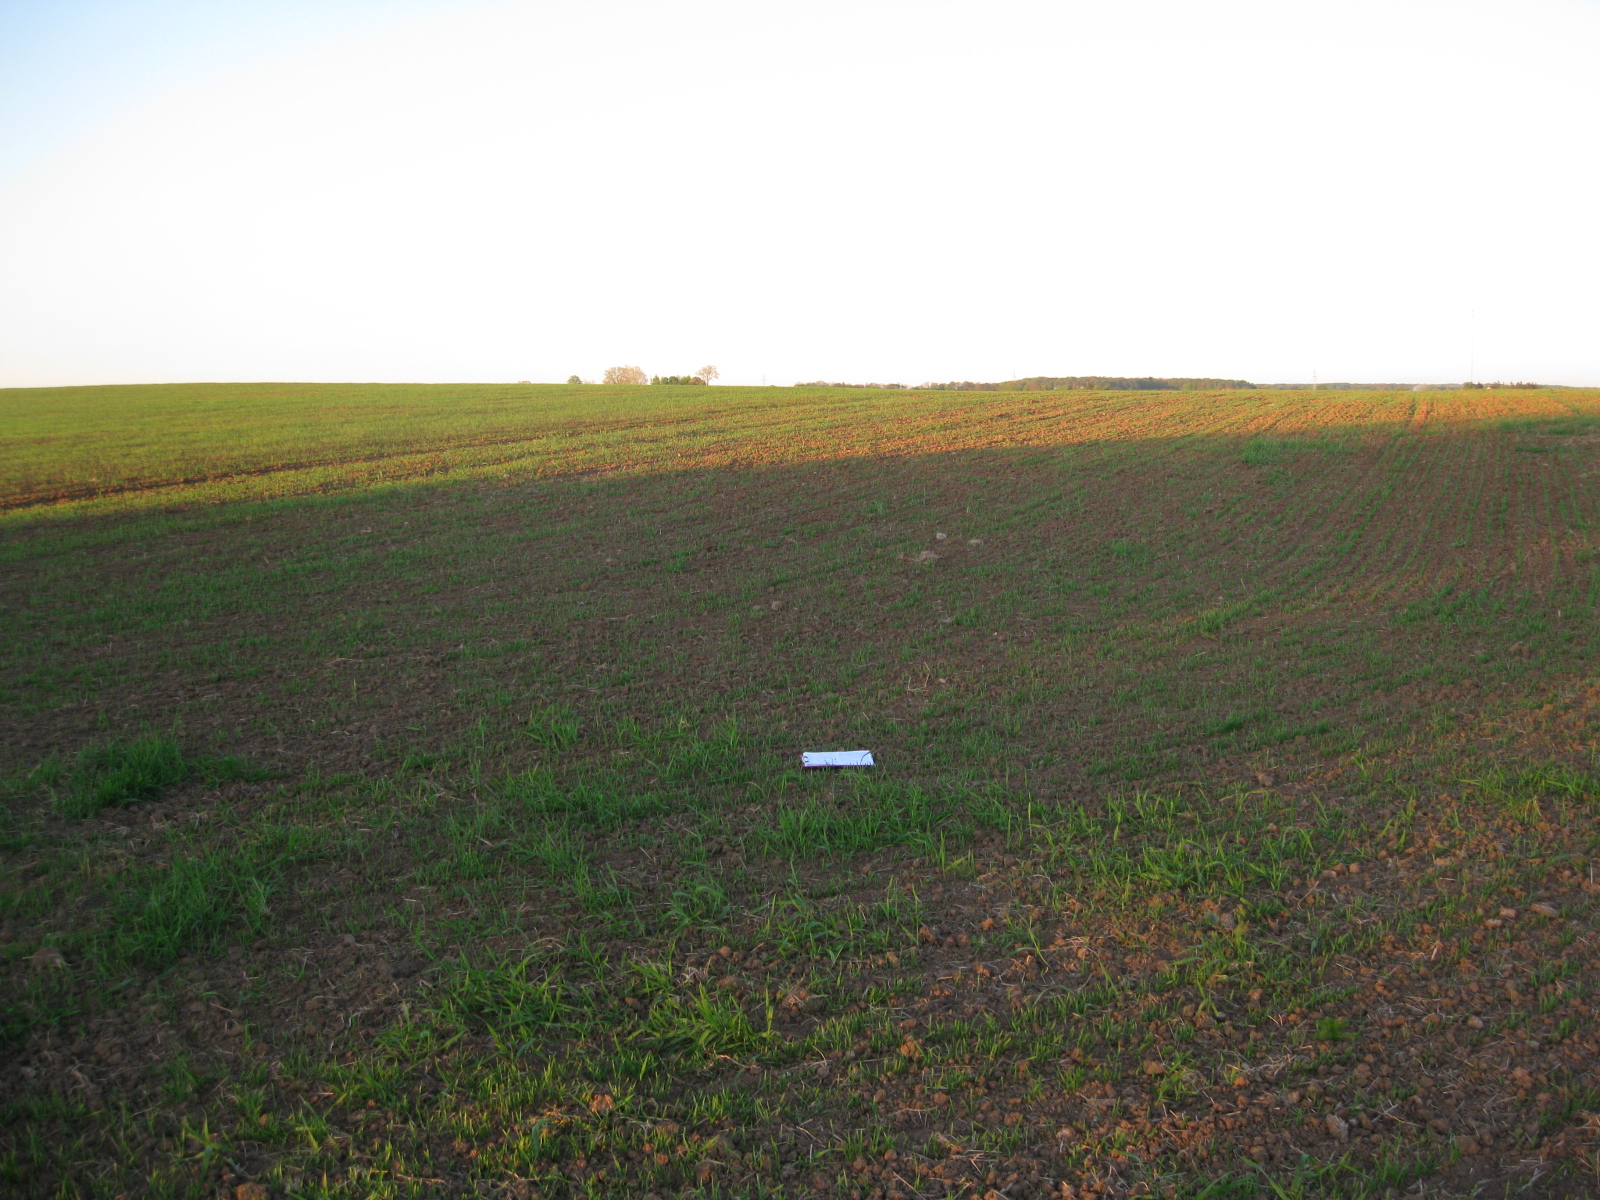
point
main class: Cropland
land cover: Common wheat
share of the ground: < 10 %
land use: Agriculture (excluding fallow land and kitchen gardens)
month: May
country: LT
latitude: 56.1168
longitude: 24.4263
